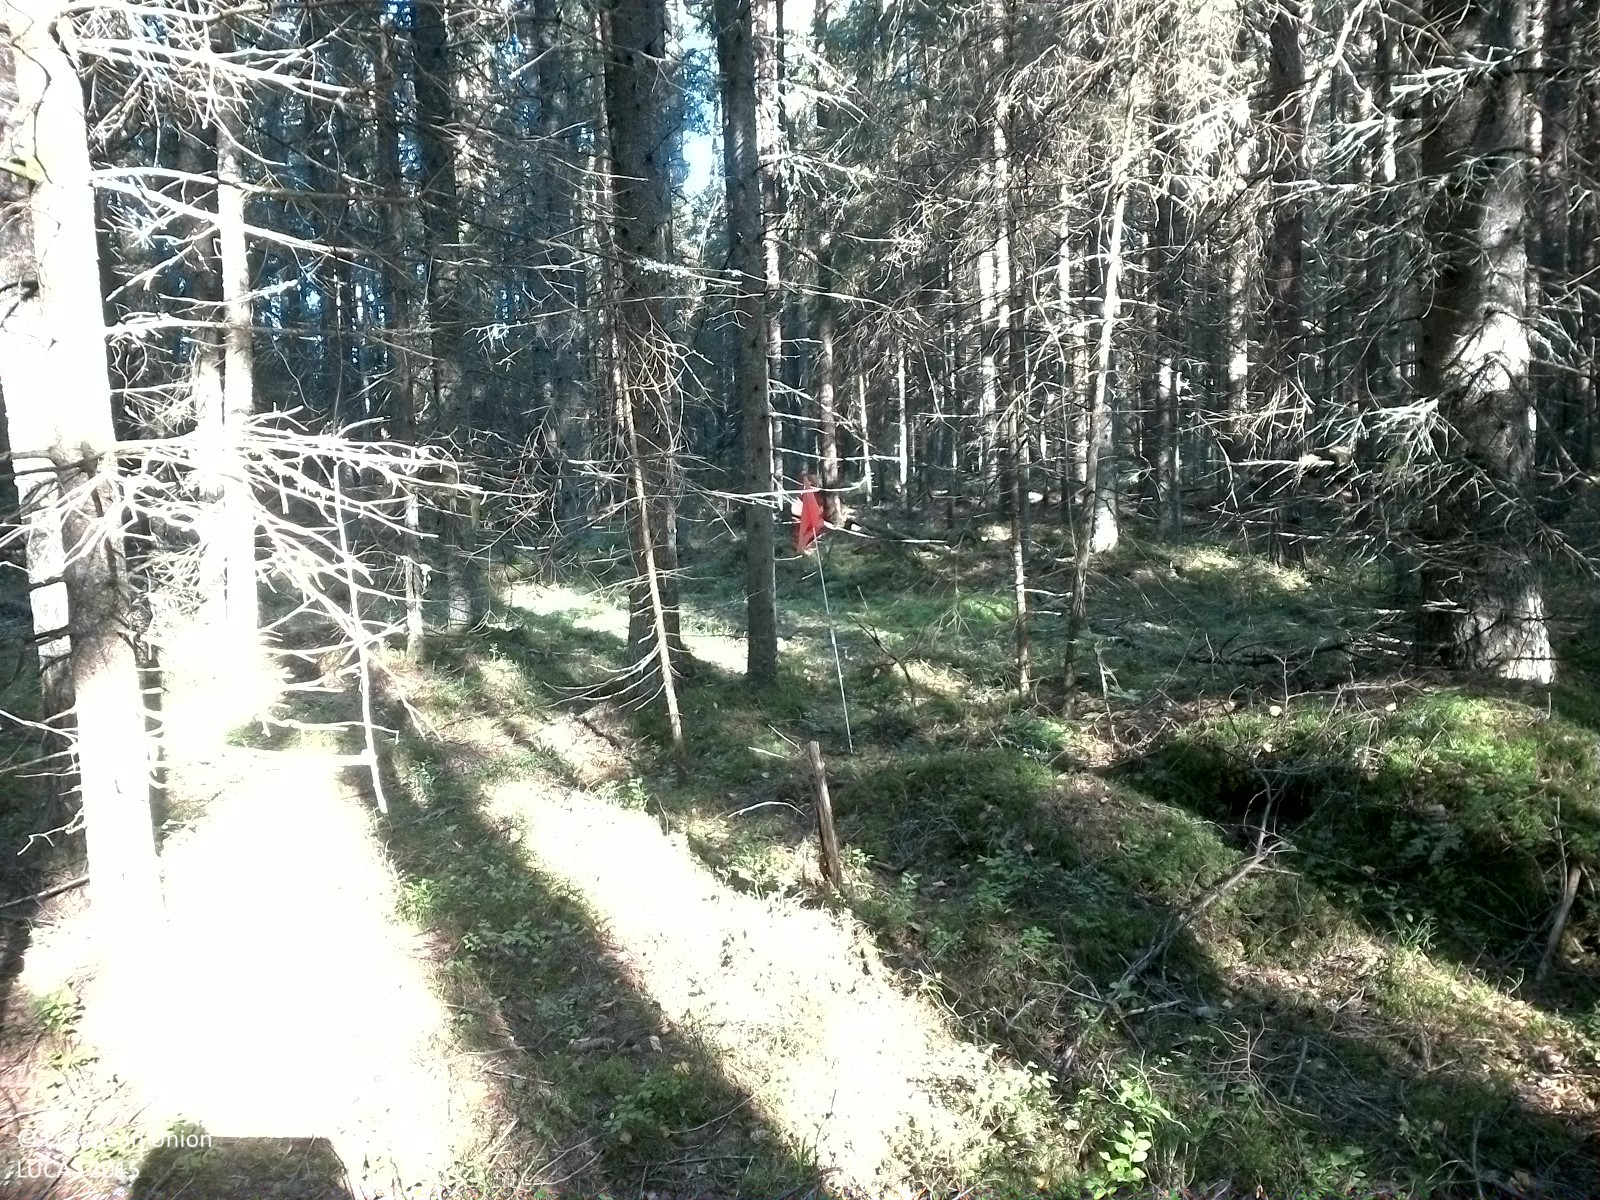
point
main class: Woodland
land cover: Other coniferous woodland
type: boreal forest
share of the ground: 50 - 75 %
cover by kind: coniferous forest trees 60 %, lichens and mosses 20 %, herbaceous plants 15 %, broadleaved forest trees 5 %
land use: Forestry
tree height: > 5 m
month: August
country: SE
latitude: 59.2961
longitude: 15.0659
